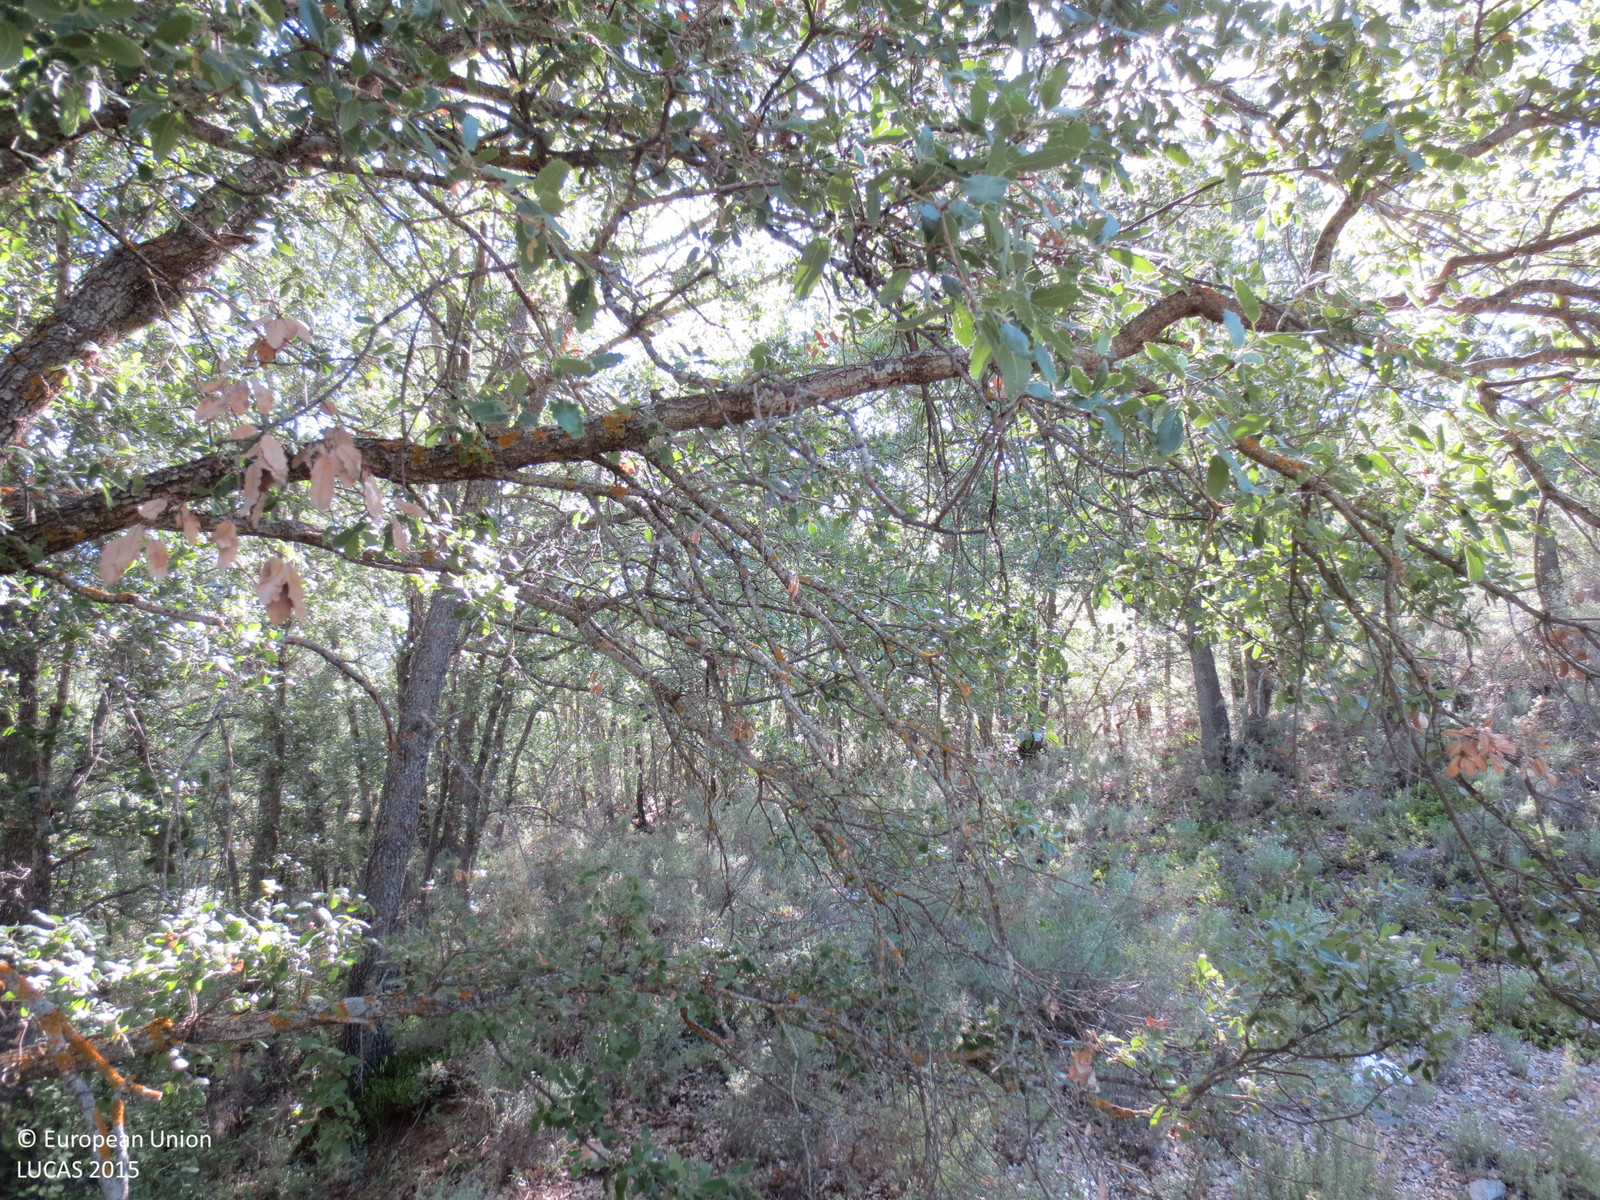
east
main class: Woodland
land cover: Broadleaved woodland
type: thermophilous deciduous forest
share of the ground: 25 - 50 %
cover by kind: broadleaved forest trees 45 %, shrubs 20 %, herbaceous plants 20 %, consolidated bare surface 10 %, coniferous forest trees 5 %
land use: Semi-natural and natural areas not in use
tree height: < 5 m
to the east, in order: Broadleaved woodland; Paved roads, cycling and walking lanes; Broadleaved woodland
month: May
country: ES
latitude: 40.6434
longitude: -2.5731
